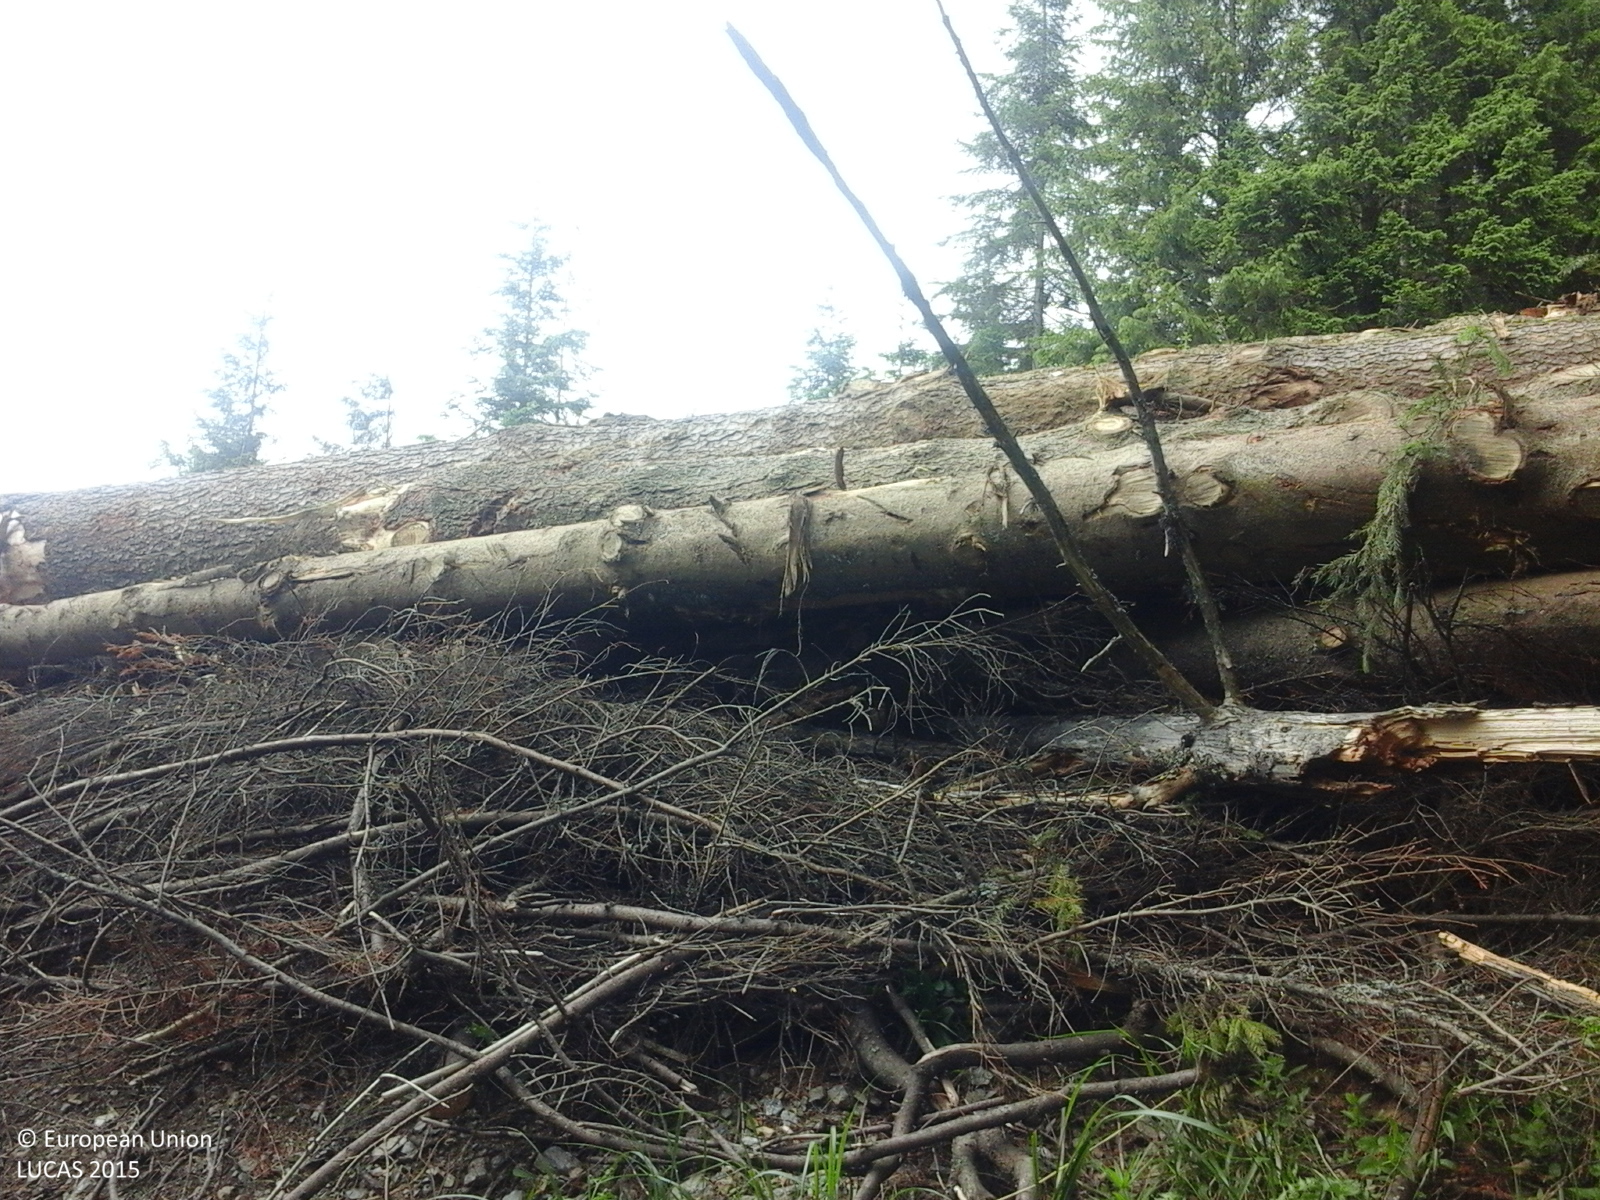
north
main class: Woodland
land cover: Spruce dominated coniferous woodland
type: alpine coniferous forest
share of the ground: > 75 %
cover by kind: coniferous forest trees 90 %, herbaceous plants 10 %
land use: Forestry
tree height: > 5 m
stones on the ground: 10 - 25 %
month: June
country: RO
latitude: 47.3072
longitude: 25.7146
